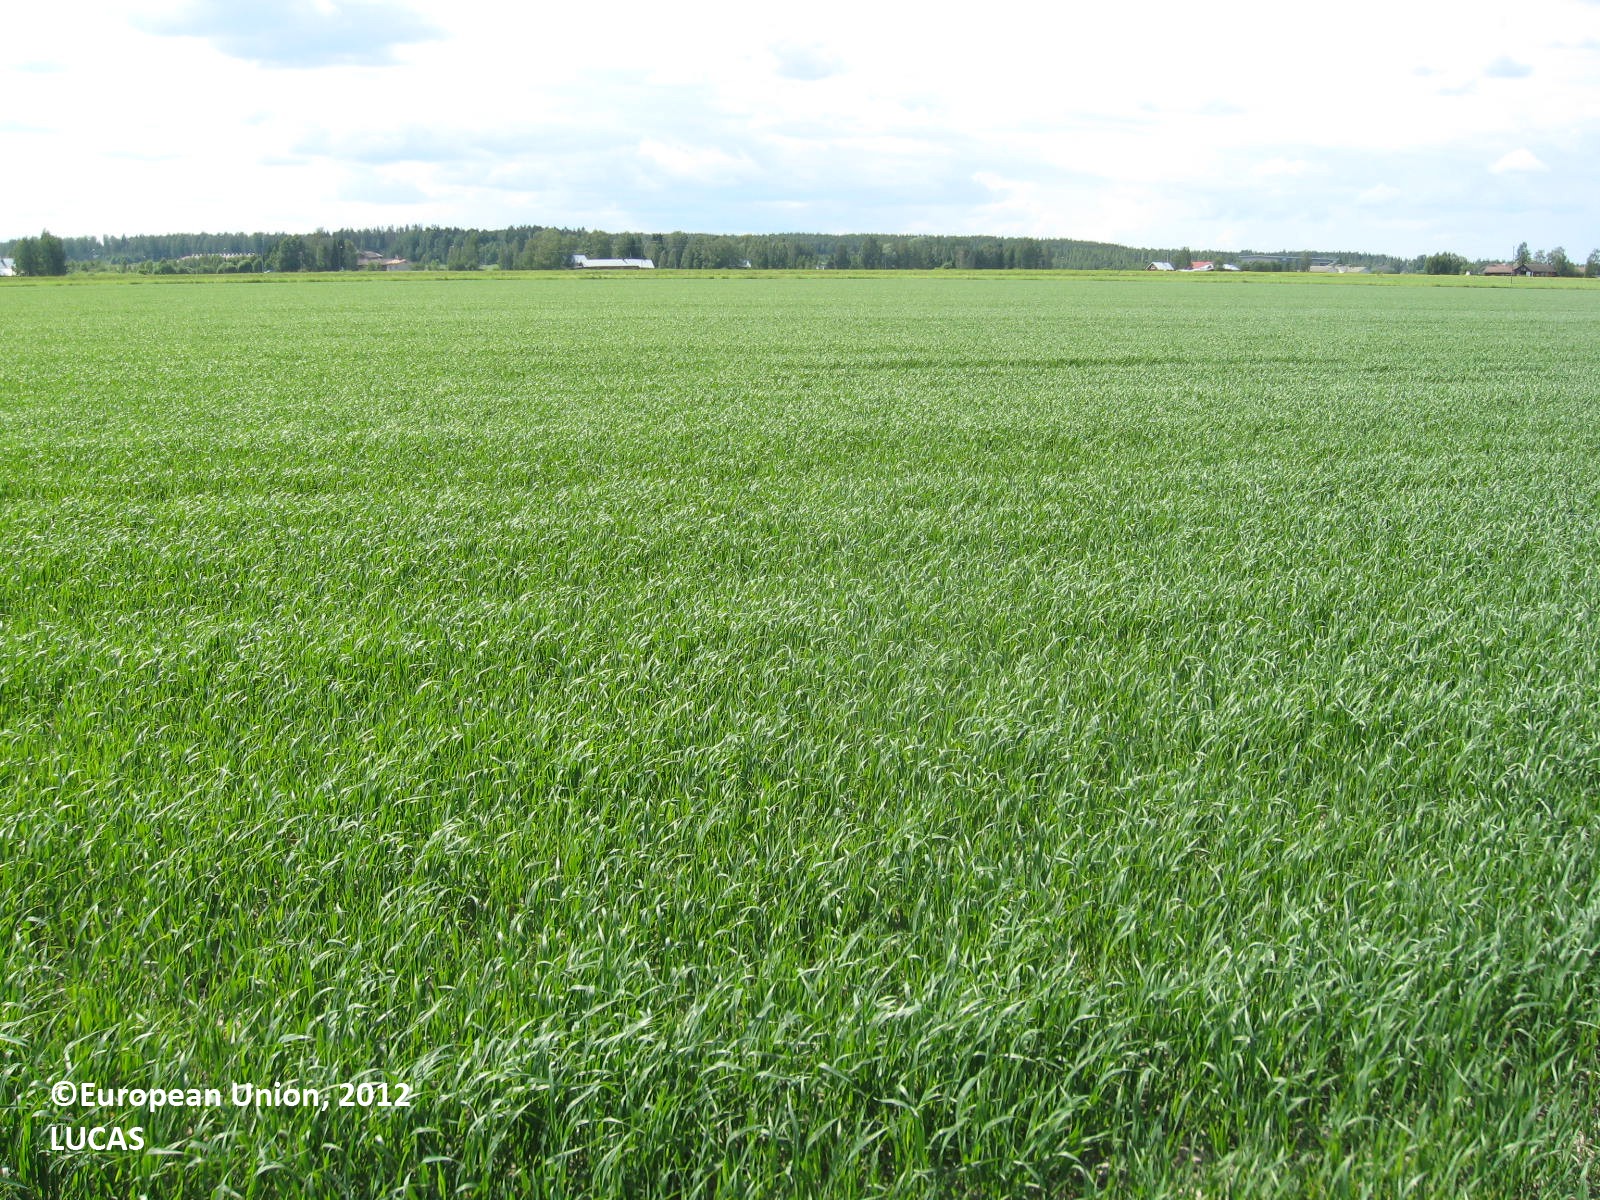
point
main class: Cropland
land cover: Oats
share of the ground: > 75 %
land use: Agriculture (excluding fallow land and kitchen gardens)
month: July
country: FI
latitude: 62.6013
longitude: 22.5018
